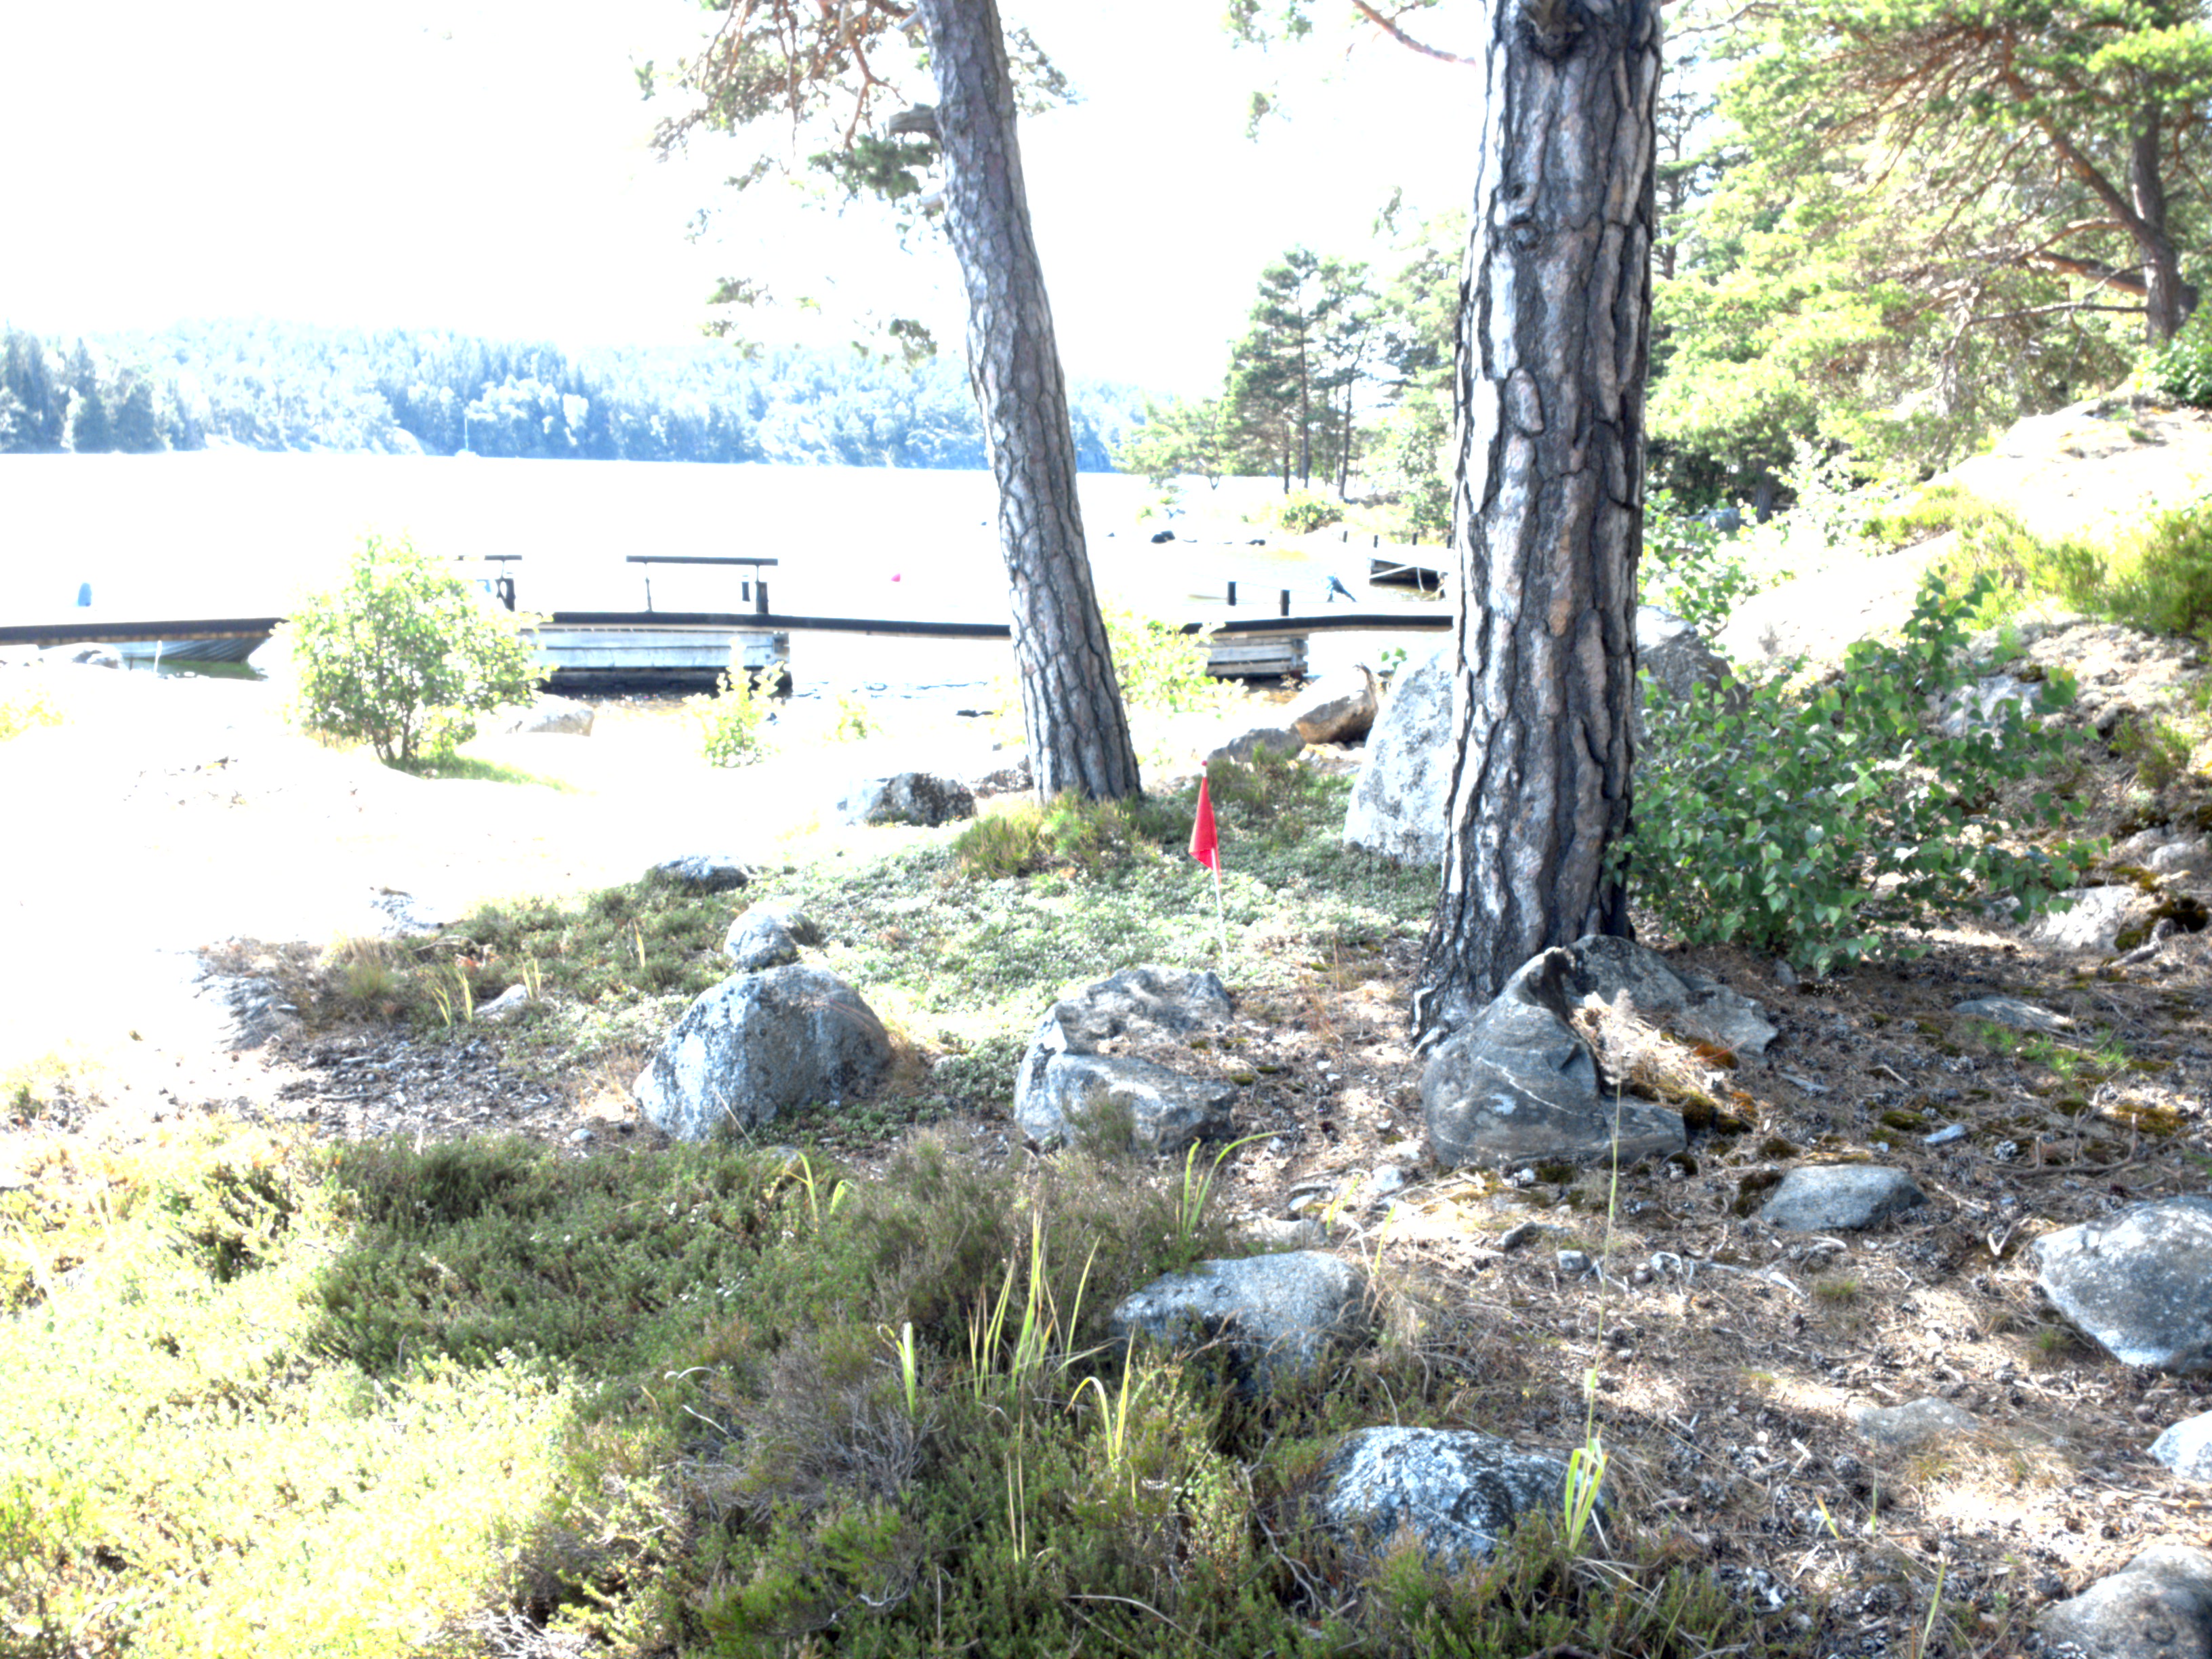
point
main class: Woodland
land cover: Pine dominated coniferous woodland
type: boreal forest
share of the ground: 25 - 50 %
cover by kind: coniferous forest trees 40 %, shrubs 40 %, lichens and mosses 20 %
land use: Amenities, museums, leisure
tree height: > 5 m
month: July
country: SE
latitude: 59.0182
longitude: 18.2040
